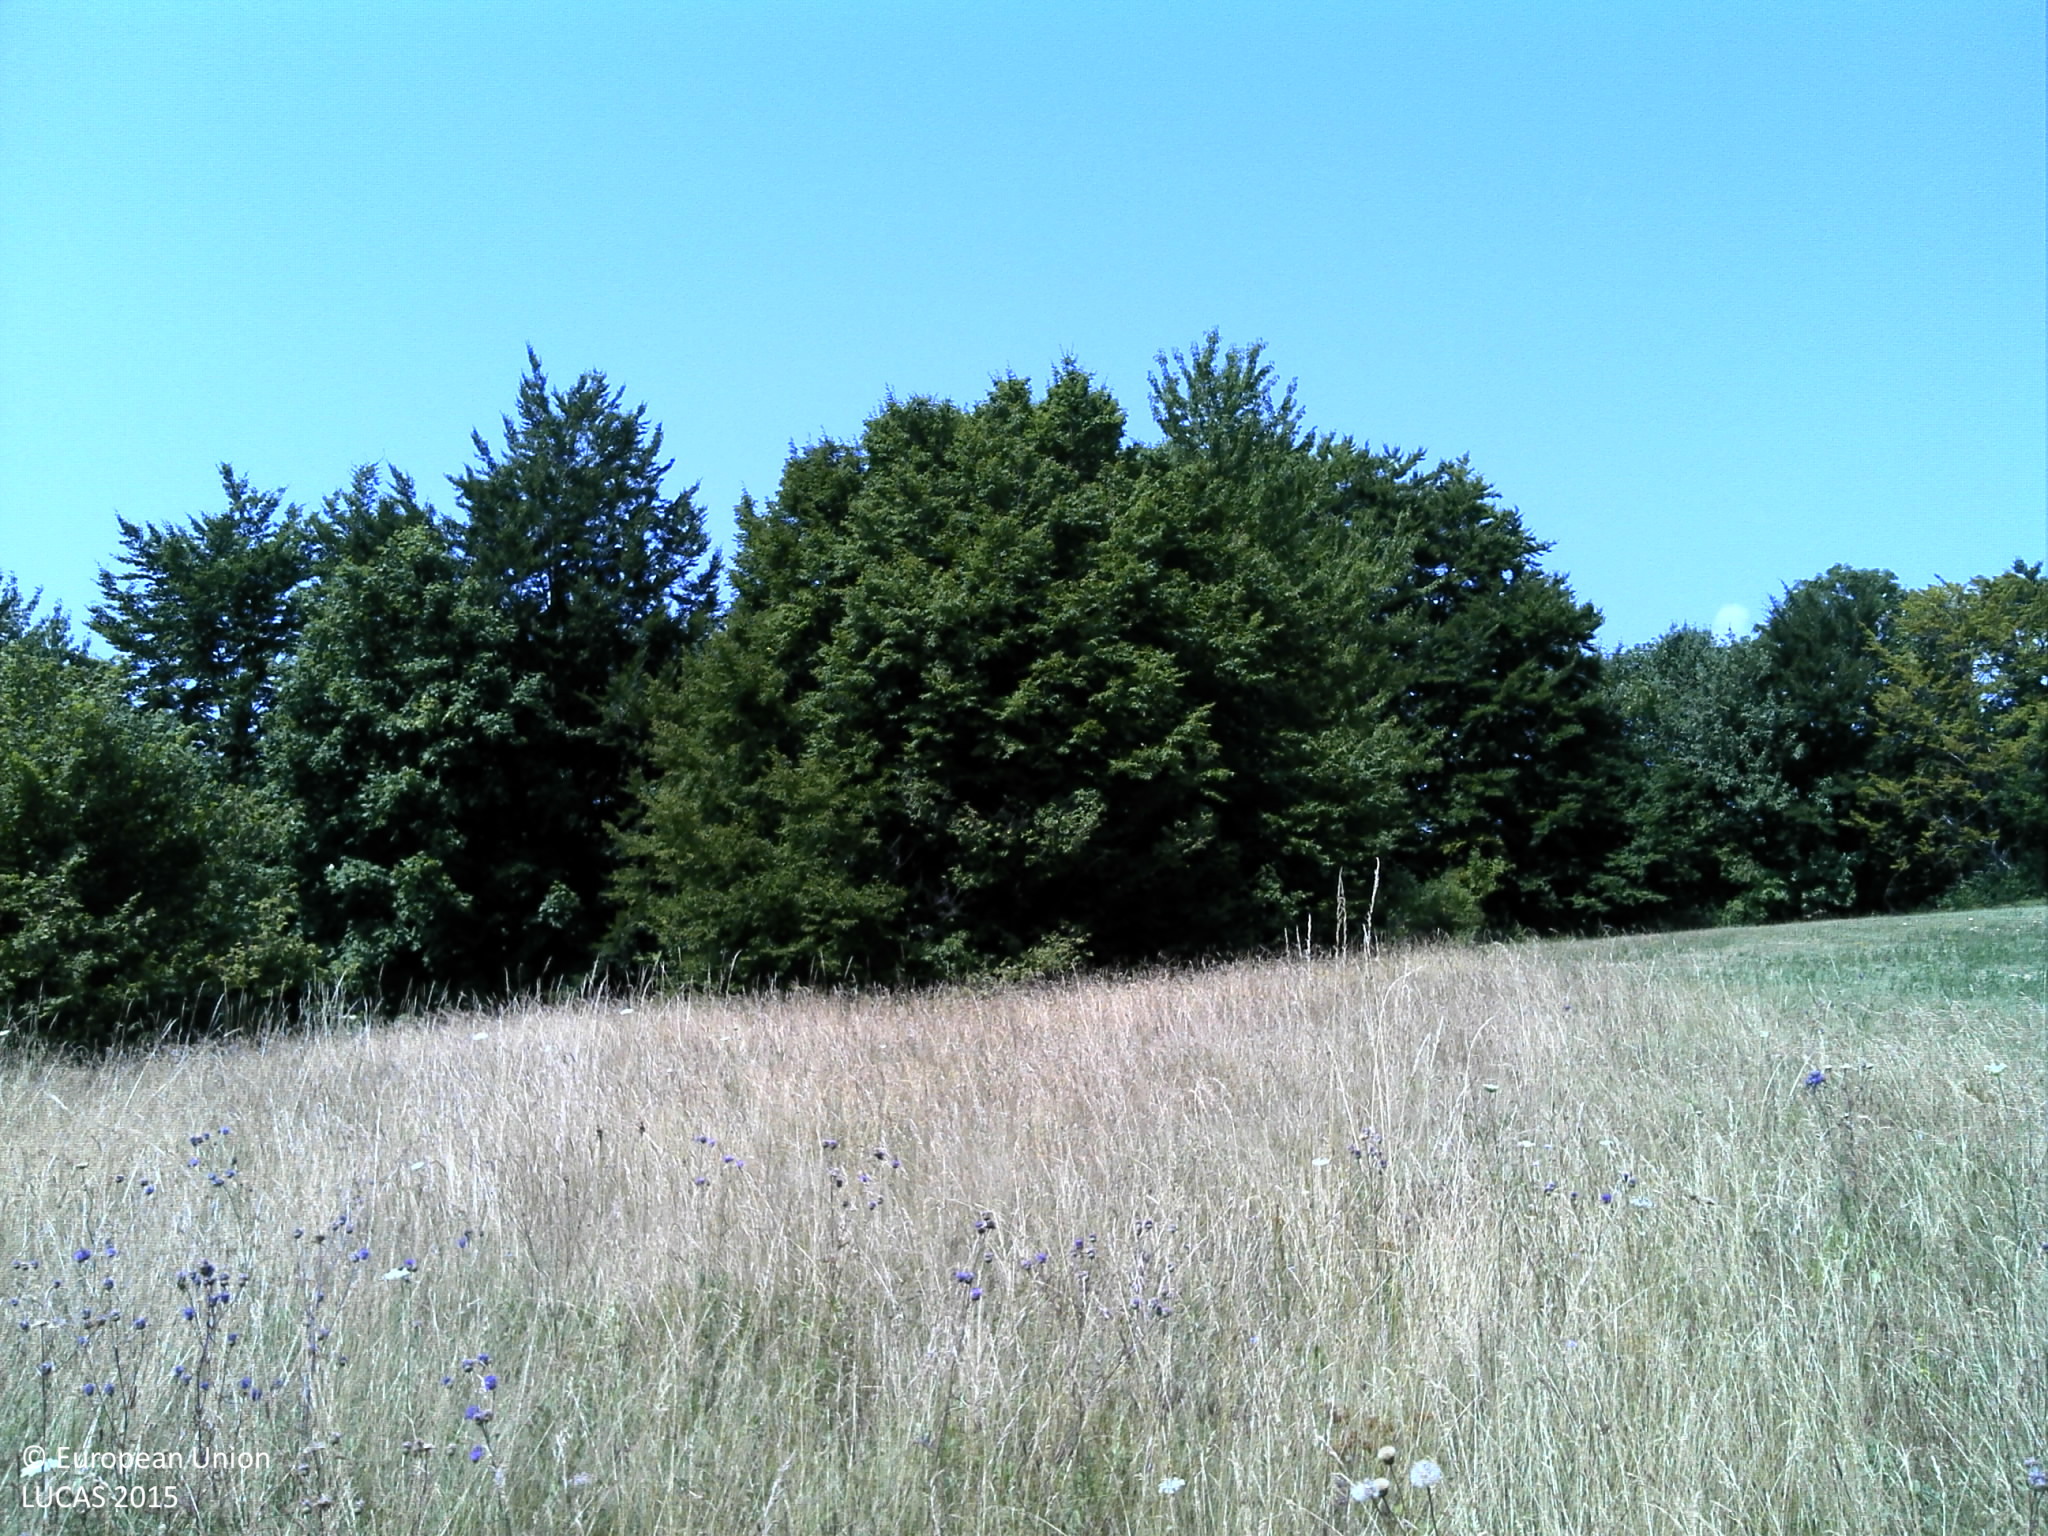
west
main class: Grassland
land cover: Grassland without tree/shrub cover
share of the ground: > 75 %
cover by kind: herbaceous plants 100 %
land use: Semi-natural and natural areas not in use
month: July
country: HR
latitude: 45.0121
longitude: 15.2604
